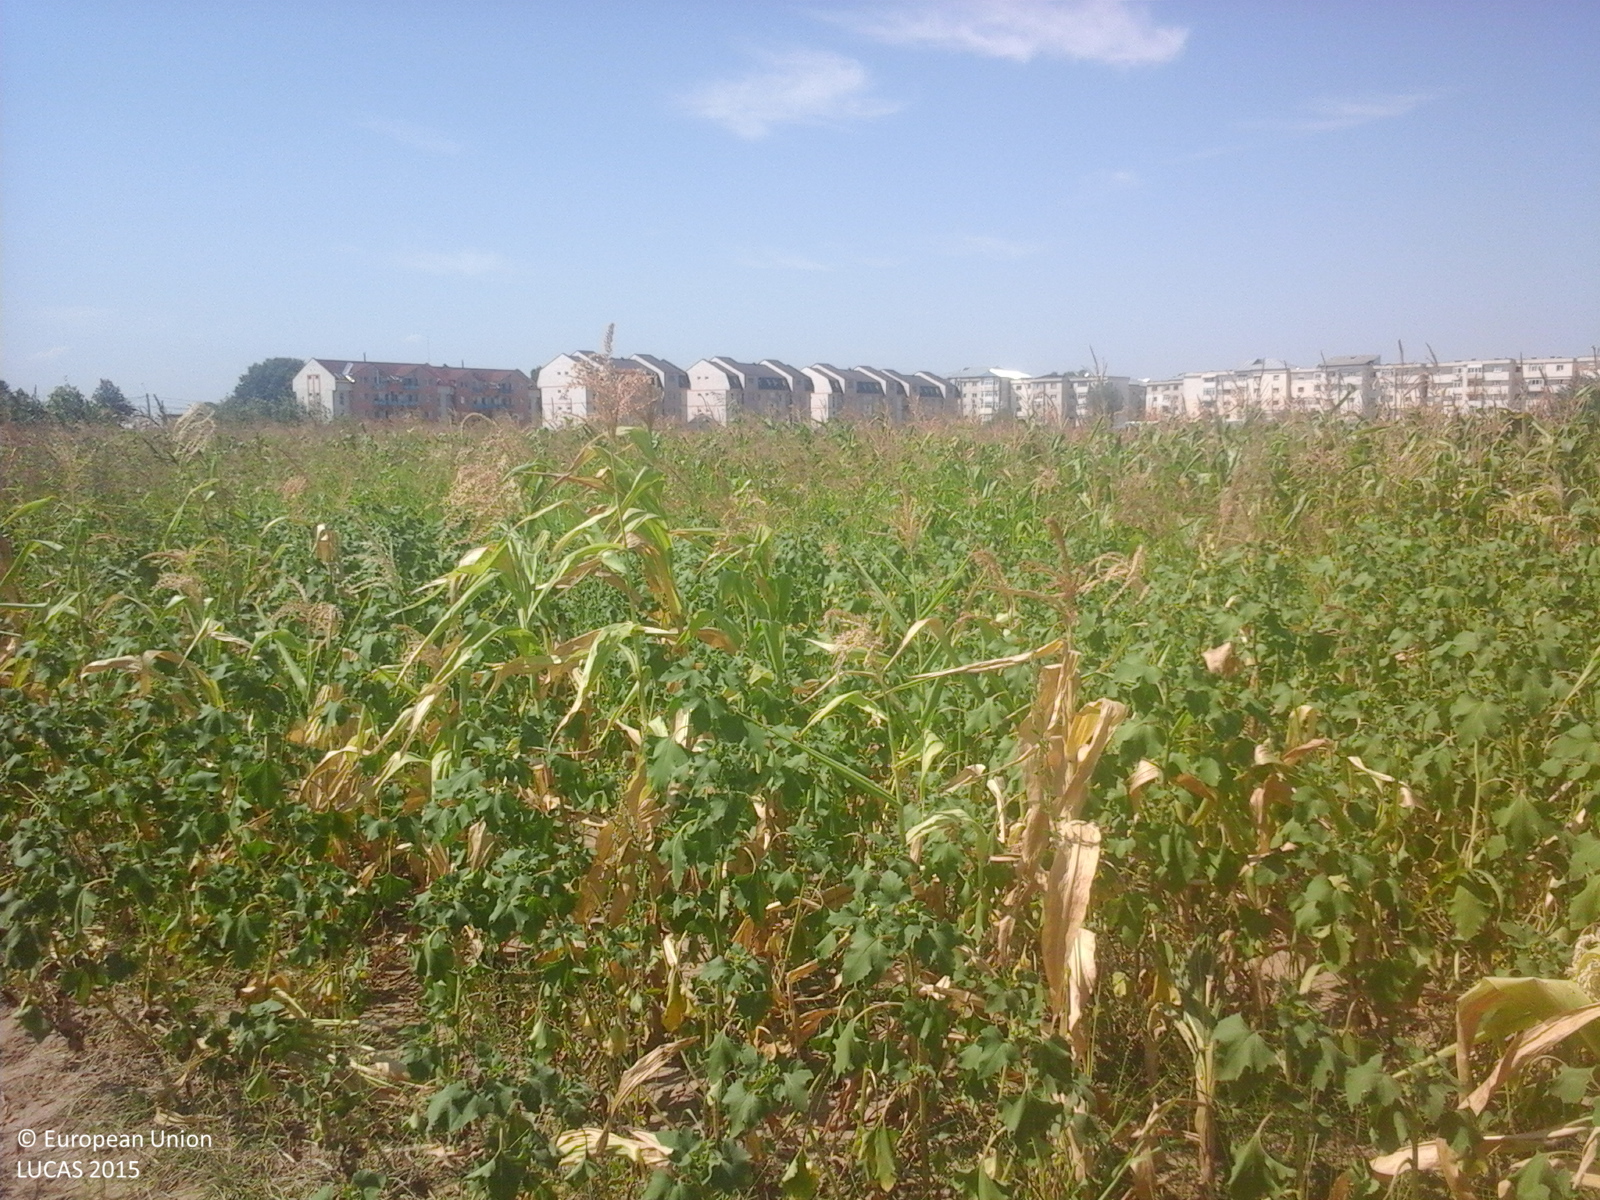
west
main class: Cropland
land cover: Lucerne
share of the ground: 50 - 75 %
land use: Agriculture (excluding fallow land and kitchen gardens)
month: August
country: RO
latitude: 45.8244
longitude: 27.4417
